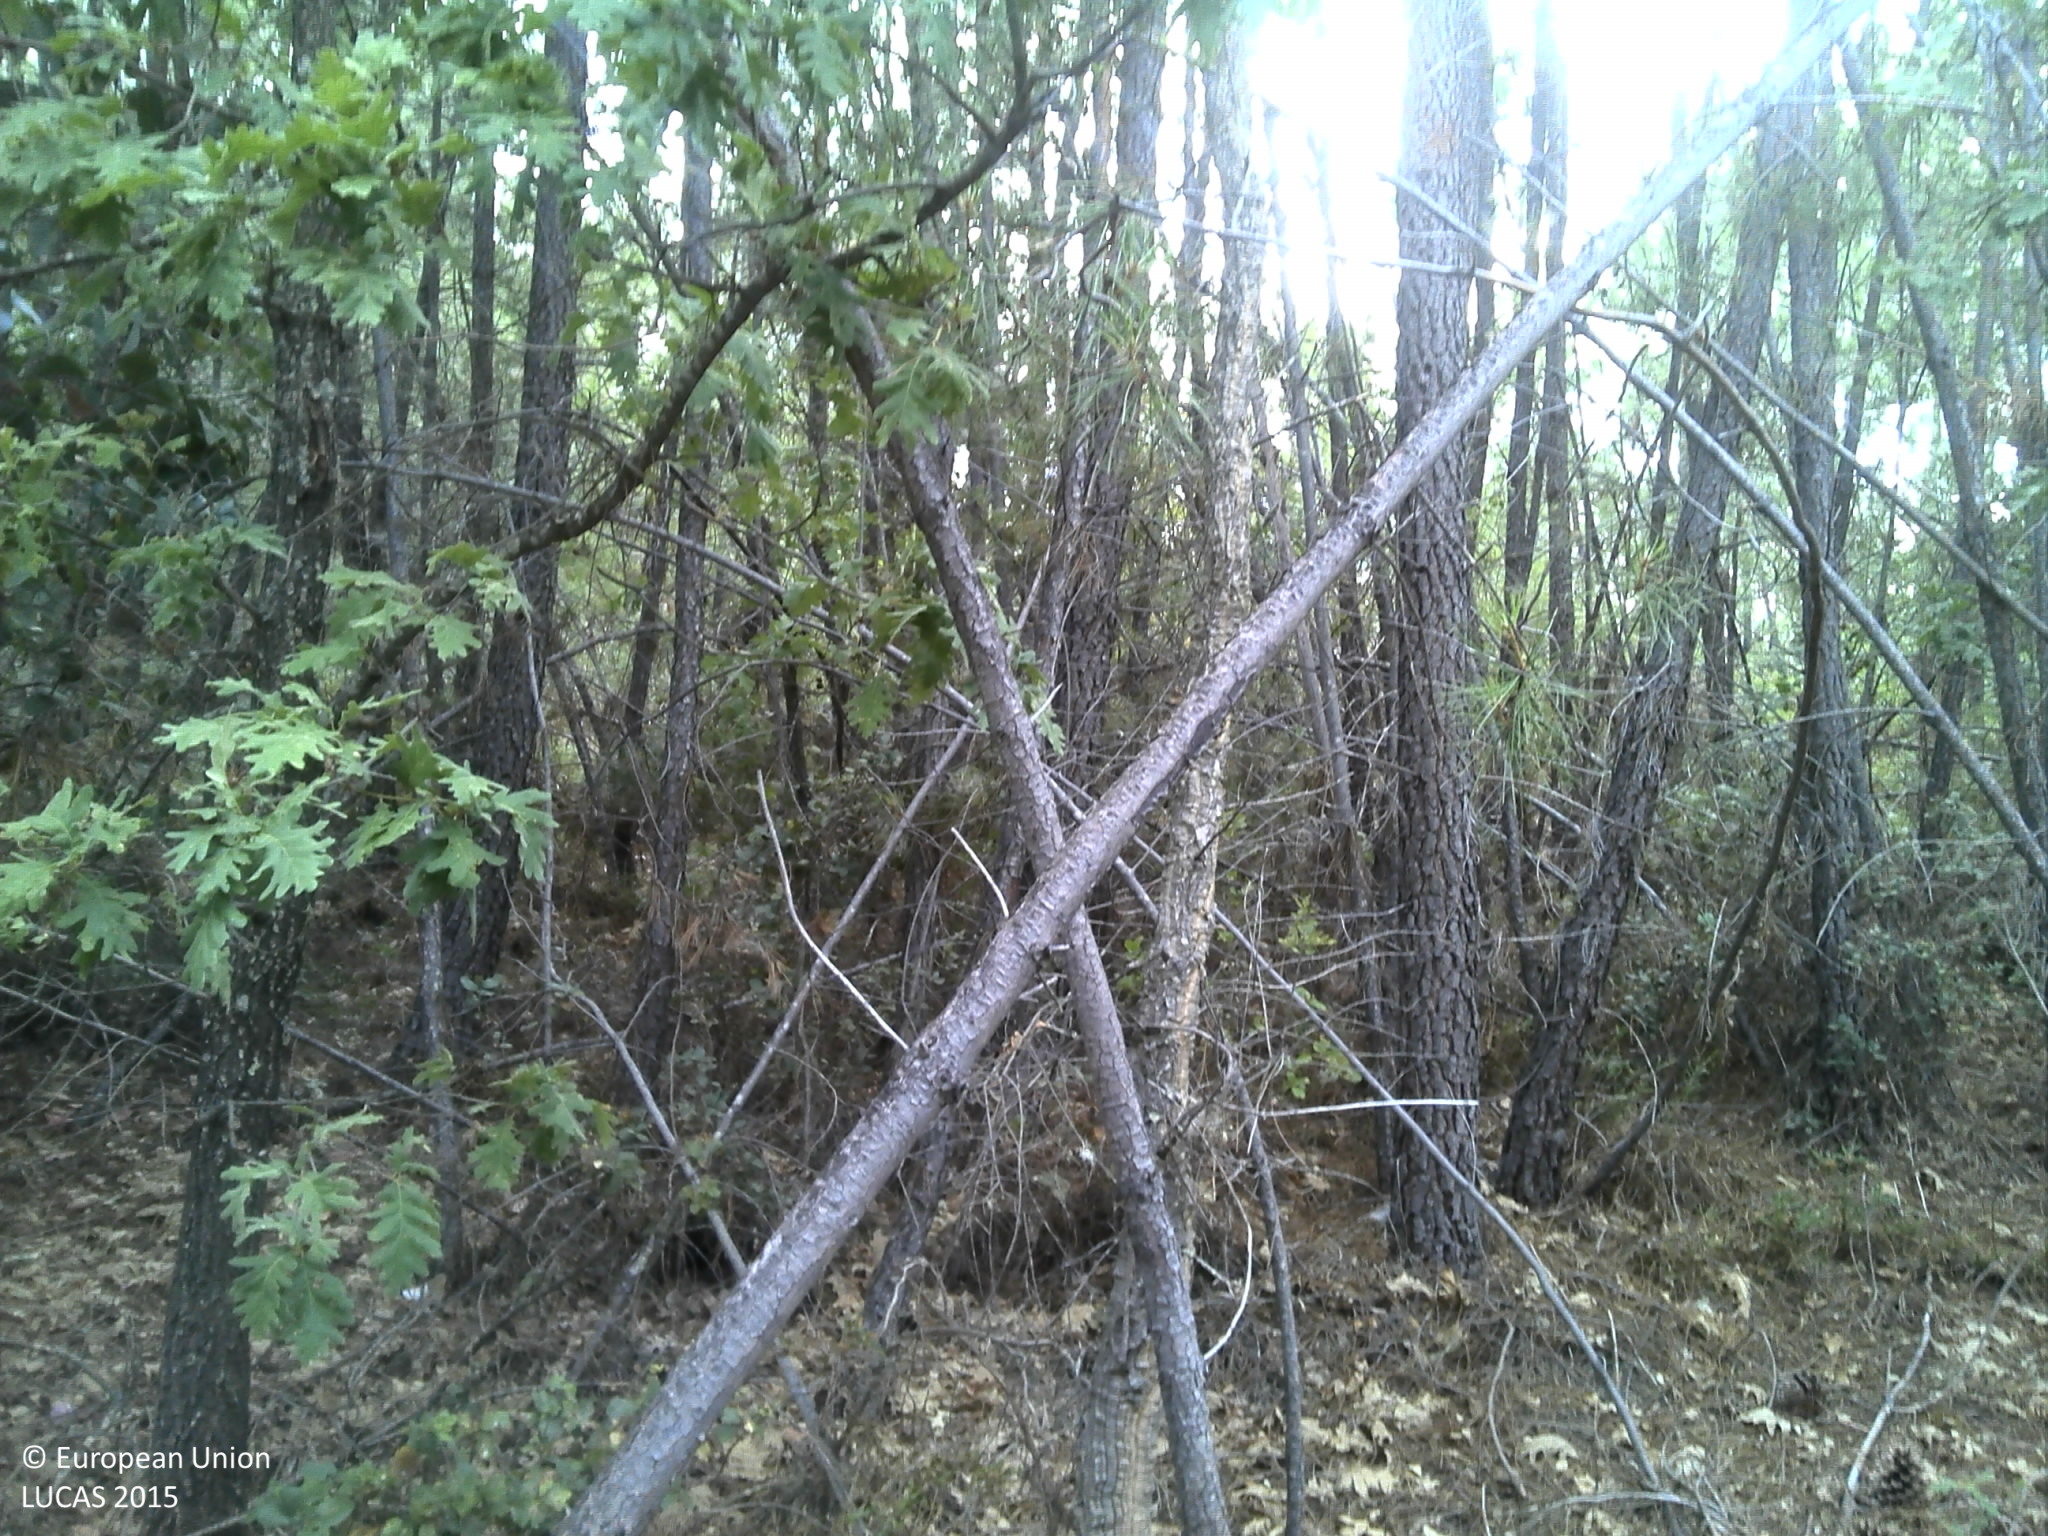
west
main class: Woodland
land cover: Pine dominated coniferous woodland
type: coniferous forest of the mediterranean region
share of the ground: 50 - 75 %
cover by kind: coniferous forest trees 55 %, shrubs 35 %, unconsolidated bare surface 10 %
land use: Forestry
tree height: > 5 m
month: June
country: PT
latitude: 40.2484
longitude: -7.3008
